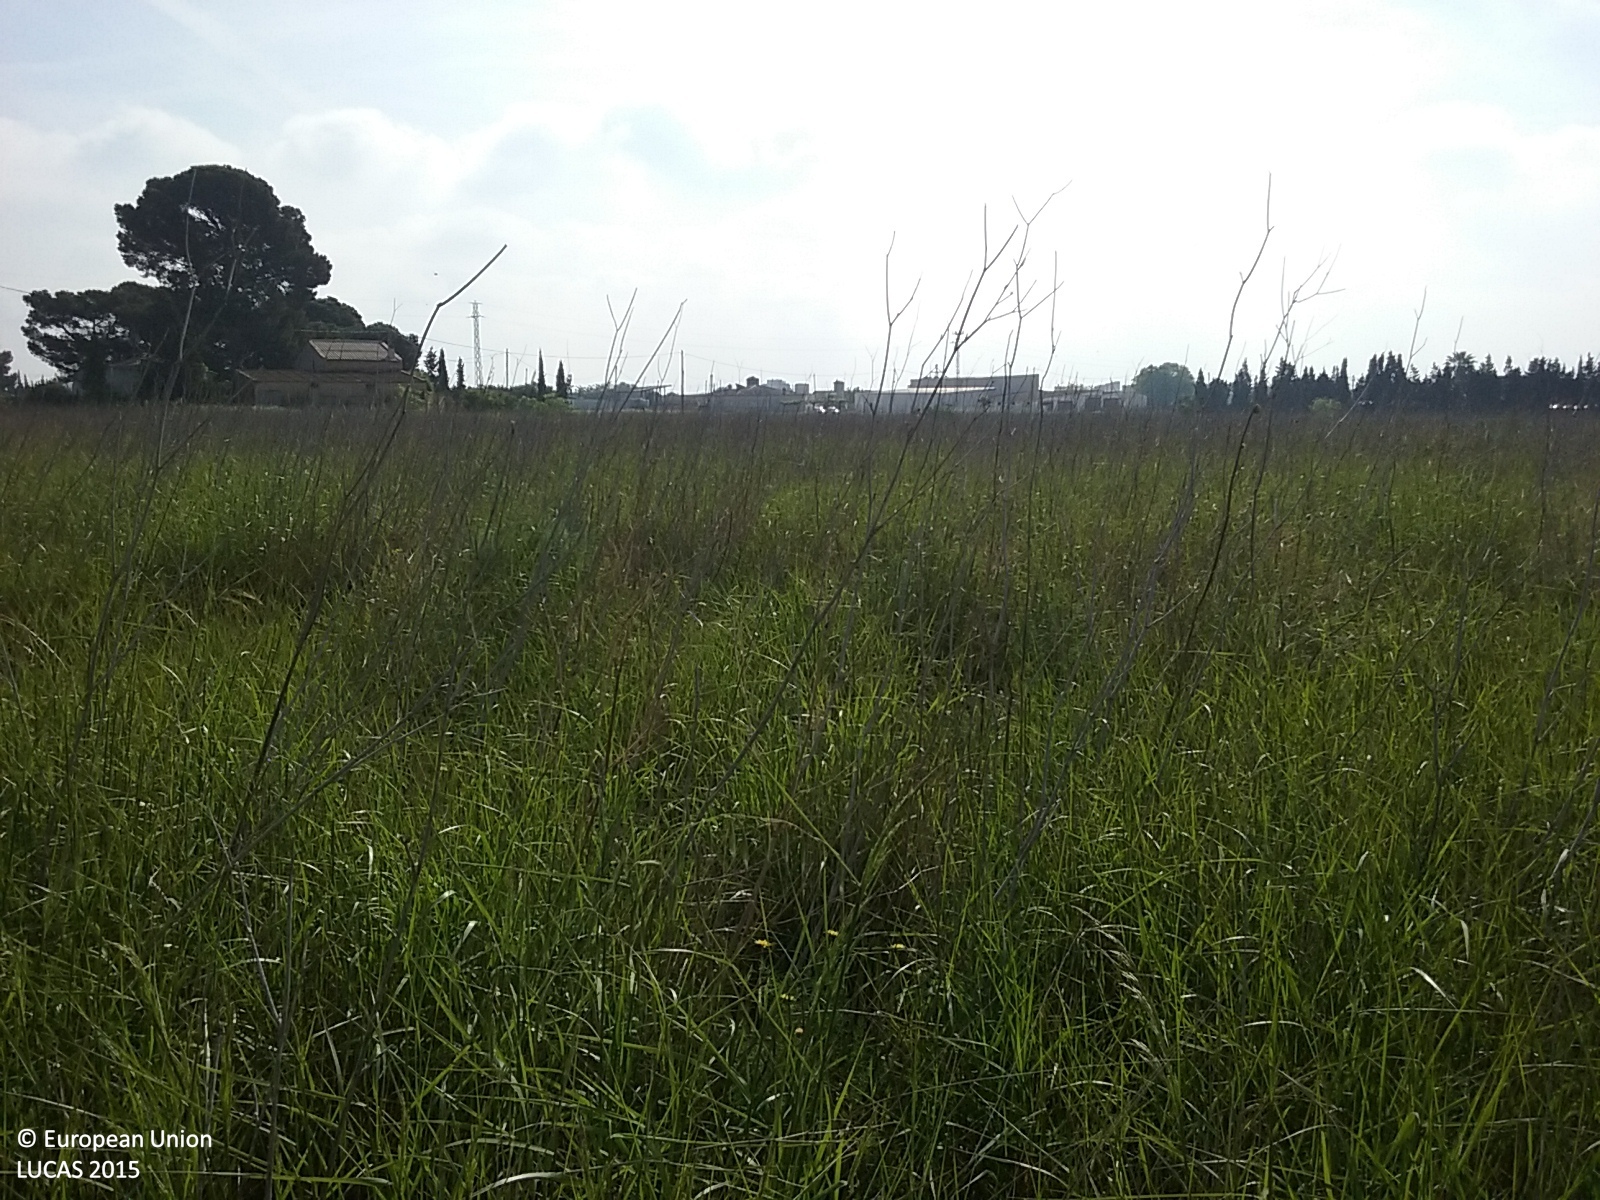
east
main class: Grassland
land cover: Grassland without tree/shrub cover
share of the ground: > 75 %
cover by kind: herbaceous plants 100 %
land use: Abandoned areas
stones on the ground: 10 - 25 %
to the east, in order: Grassland without tree/shrub cover; Ditches and canals; Grassland without tree/shrub cover; Electric lines; Grassland without tree/shrub cover; Artificial constructions; Paved roads, cycling and walking lanes; Barley; Electric lines; Barley
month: April
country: ES
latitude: 40.7436
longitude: 0.6035
